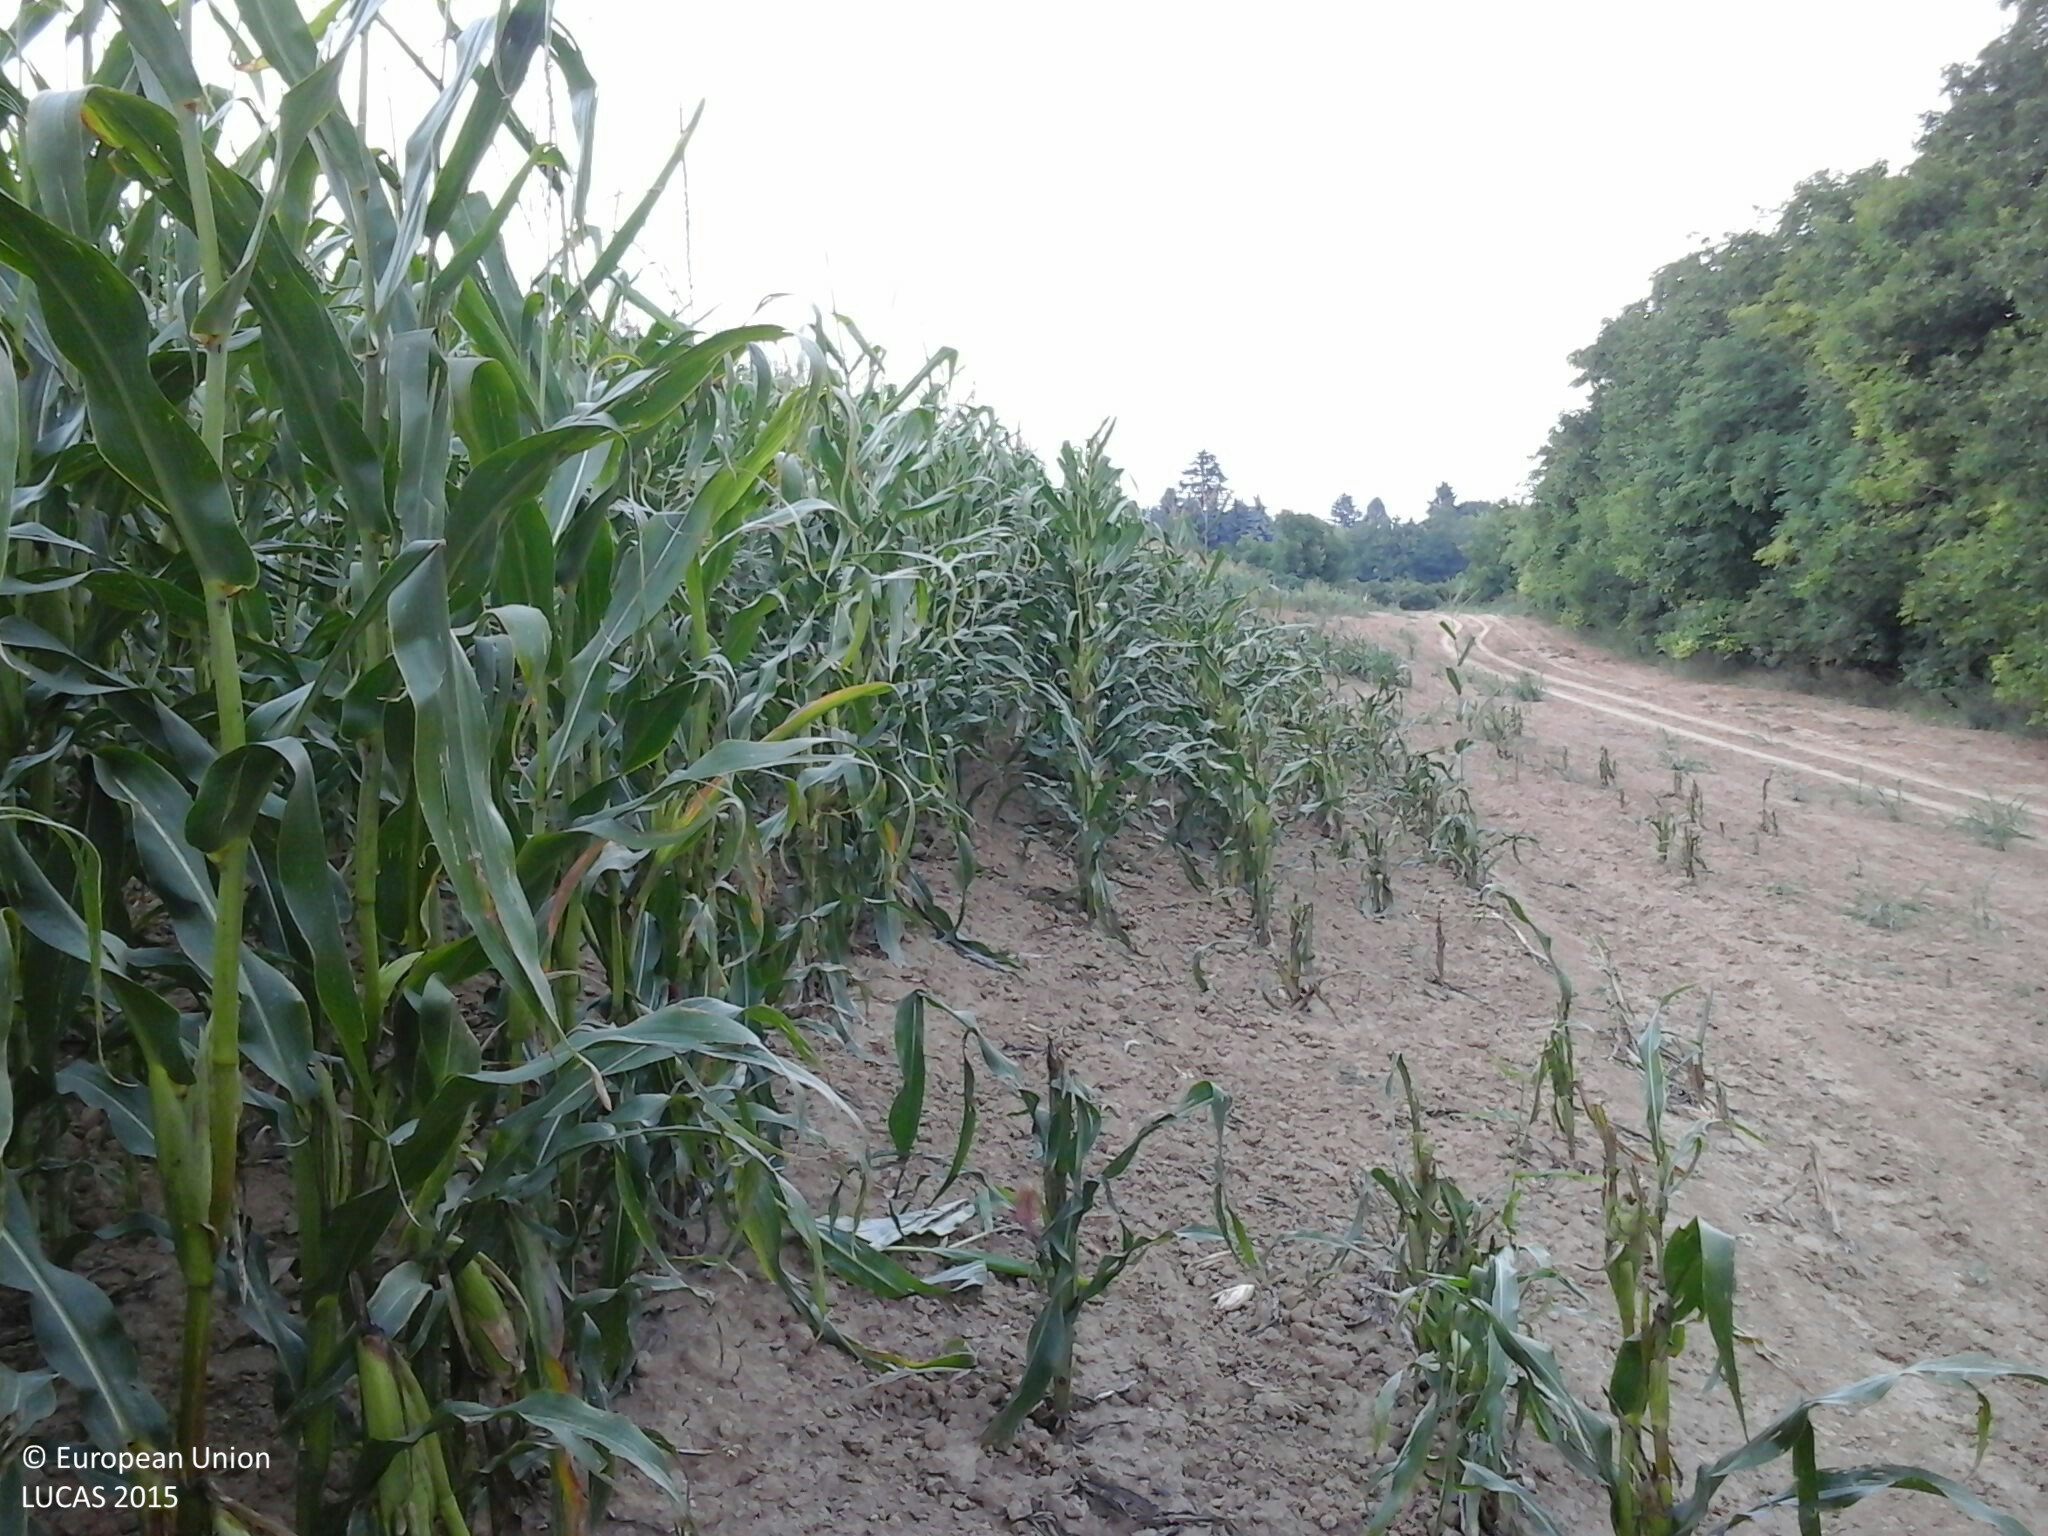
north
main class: Cropland
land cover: Maize
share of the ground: > 75 %
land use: Agriculture (excluding fallow land and kitchen gardens)
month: August
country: HU
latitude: 45.9734
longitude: 18.3059
